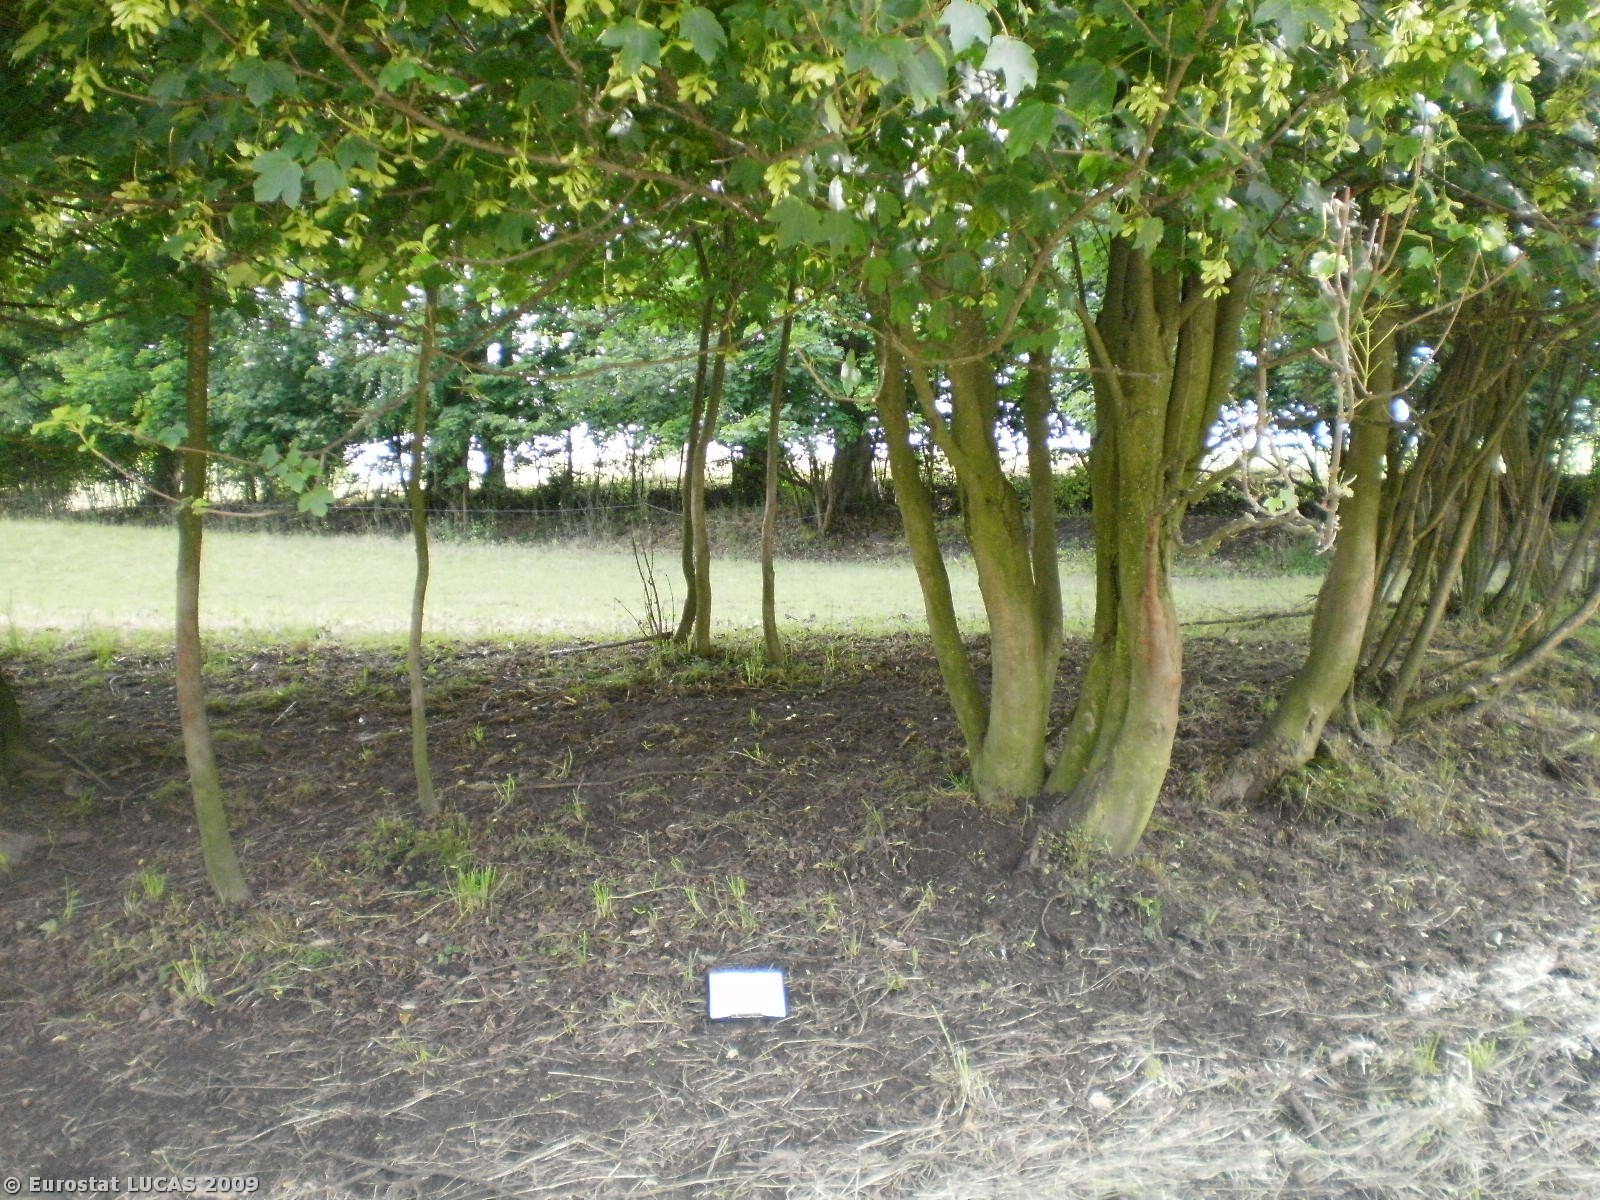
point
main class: Grassland
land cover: Grassland with sparse tree/shrub cover
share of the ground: > 75 %
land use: Agriculture (excluding fallow land and kitchen gardens)
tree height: > 5 m
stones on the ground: < 10 %
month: June
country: PL
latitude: 53.5579
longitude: 19.8882
